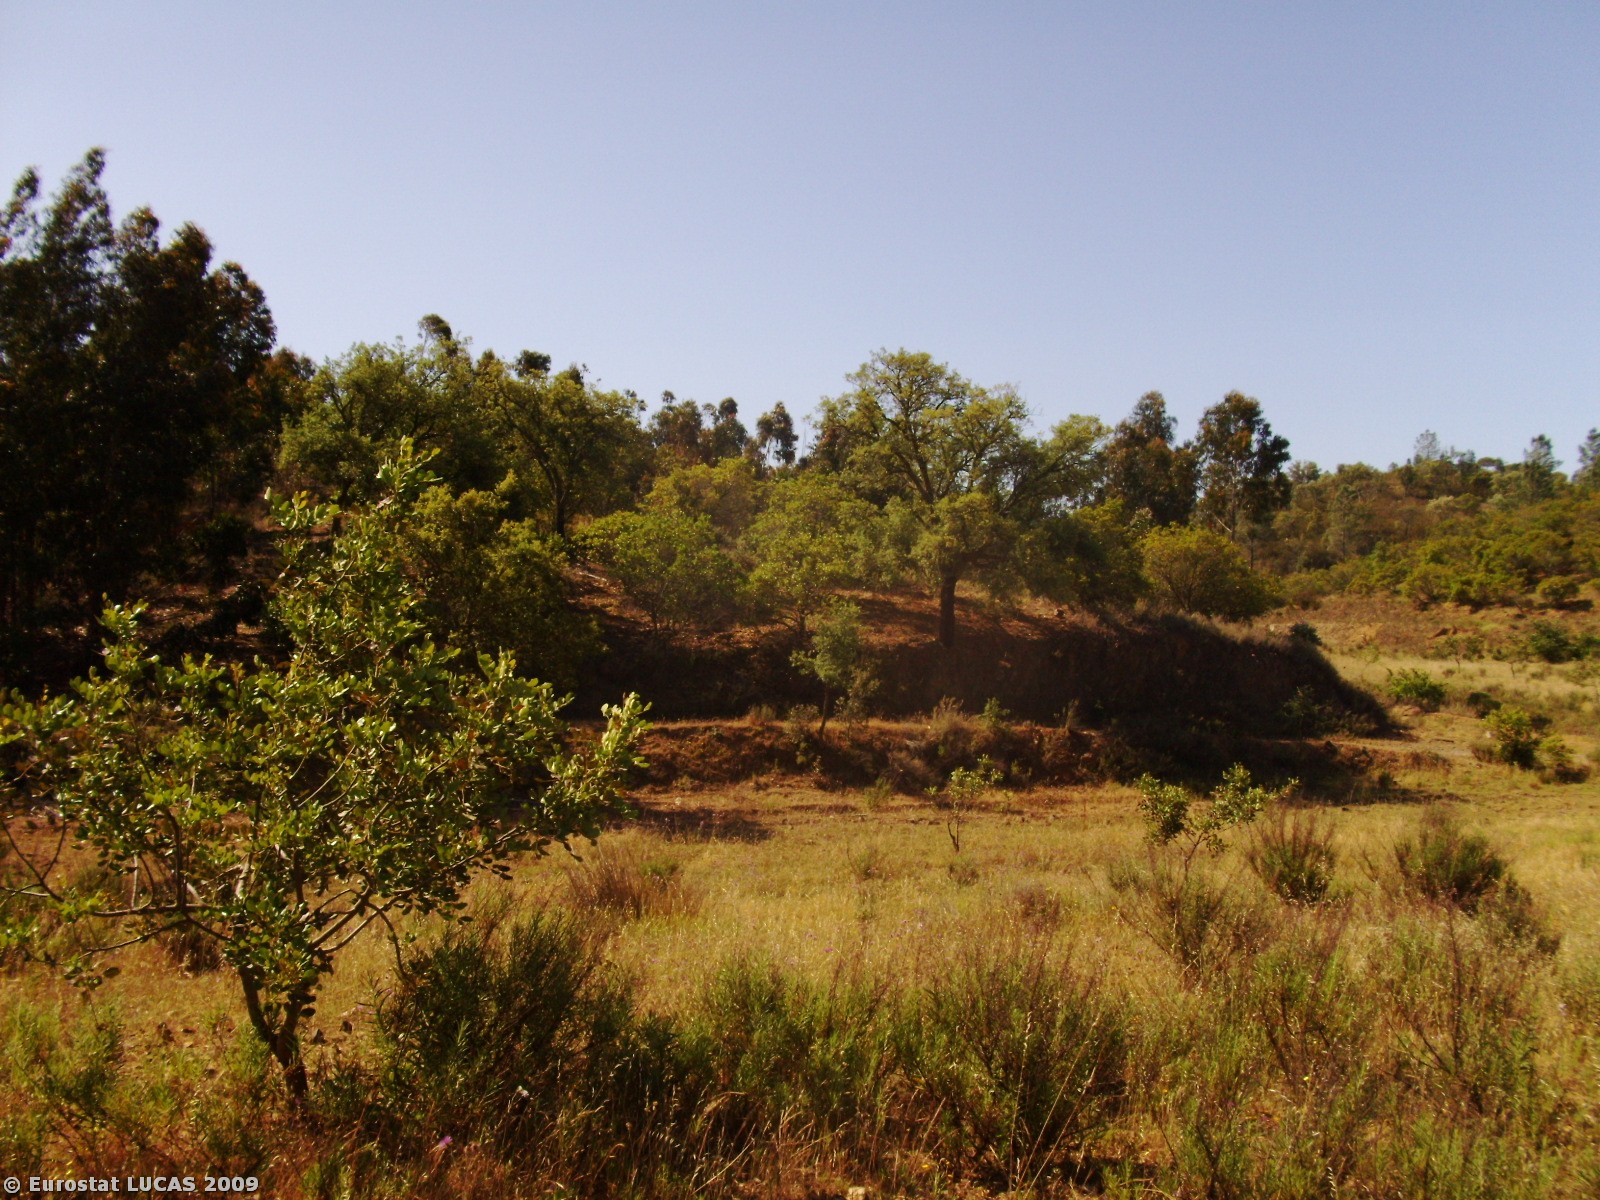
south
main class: Cropland
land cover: Permanent industrial crops
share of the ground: 10 - 25 %
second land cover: Spontaneously vegetated surfaces
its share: 25 - 50 %
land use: Agriculture (excluding fallow land and kitchen gardens)
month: May
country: PT
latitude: 37.2789
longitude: -8.2589
